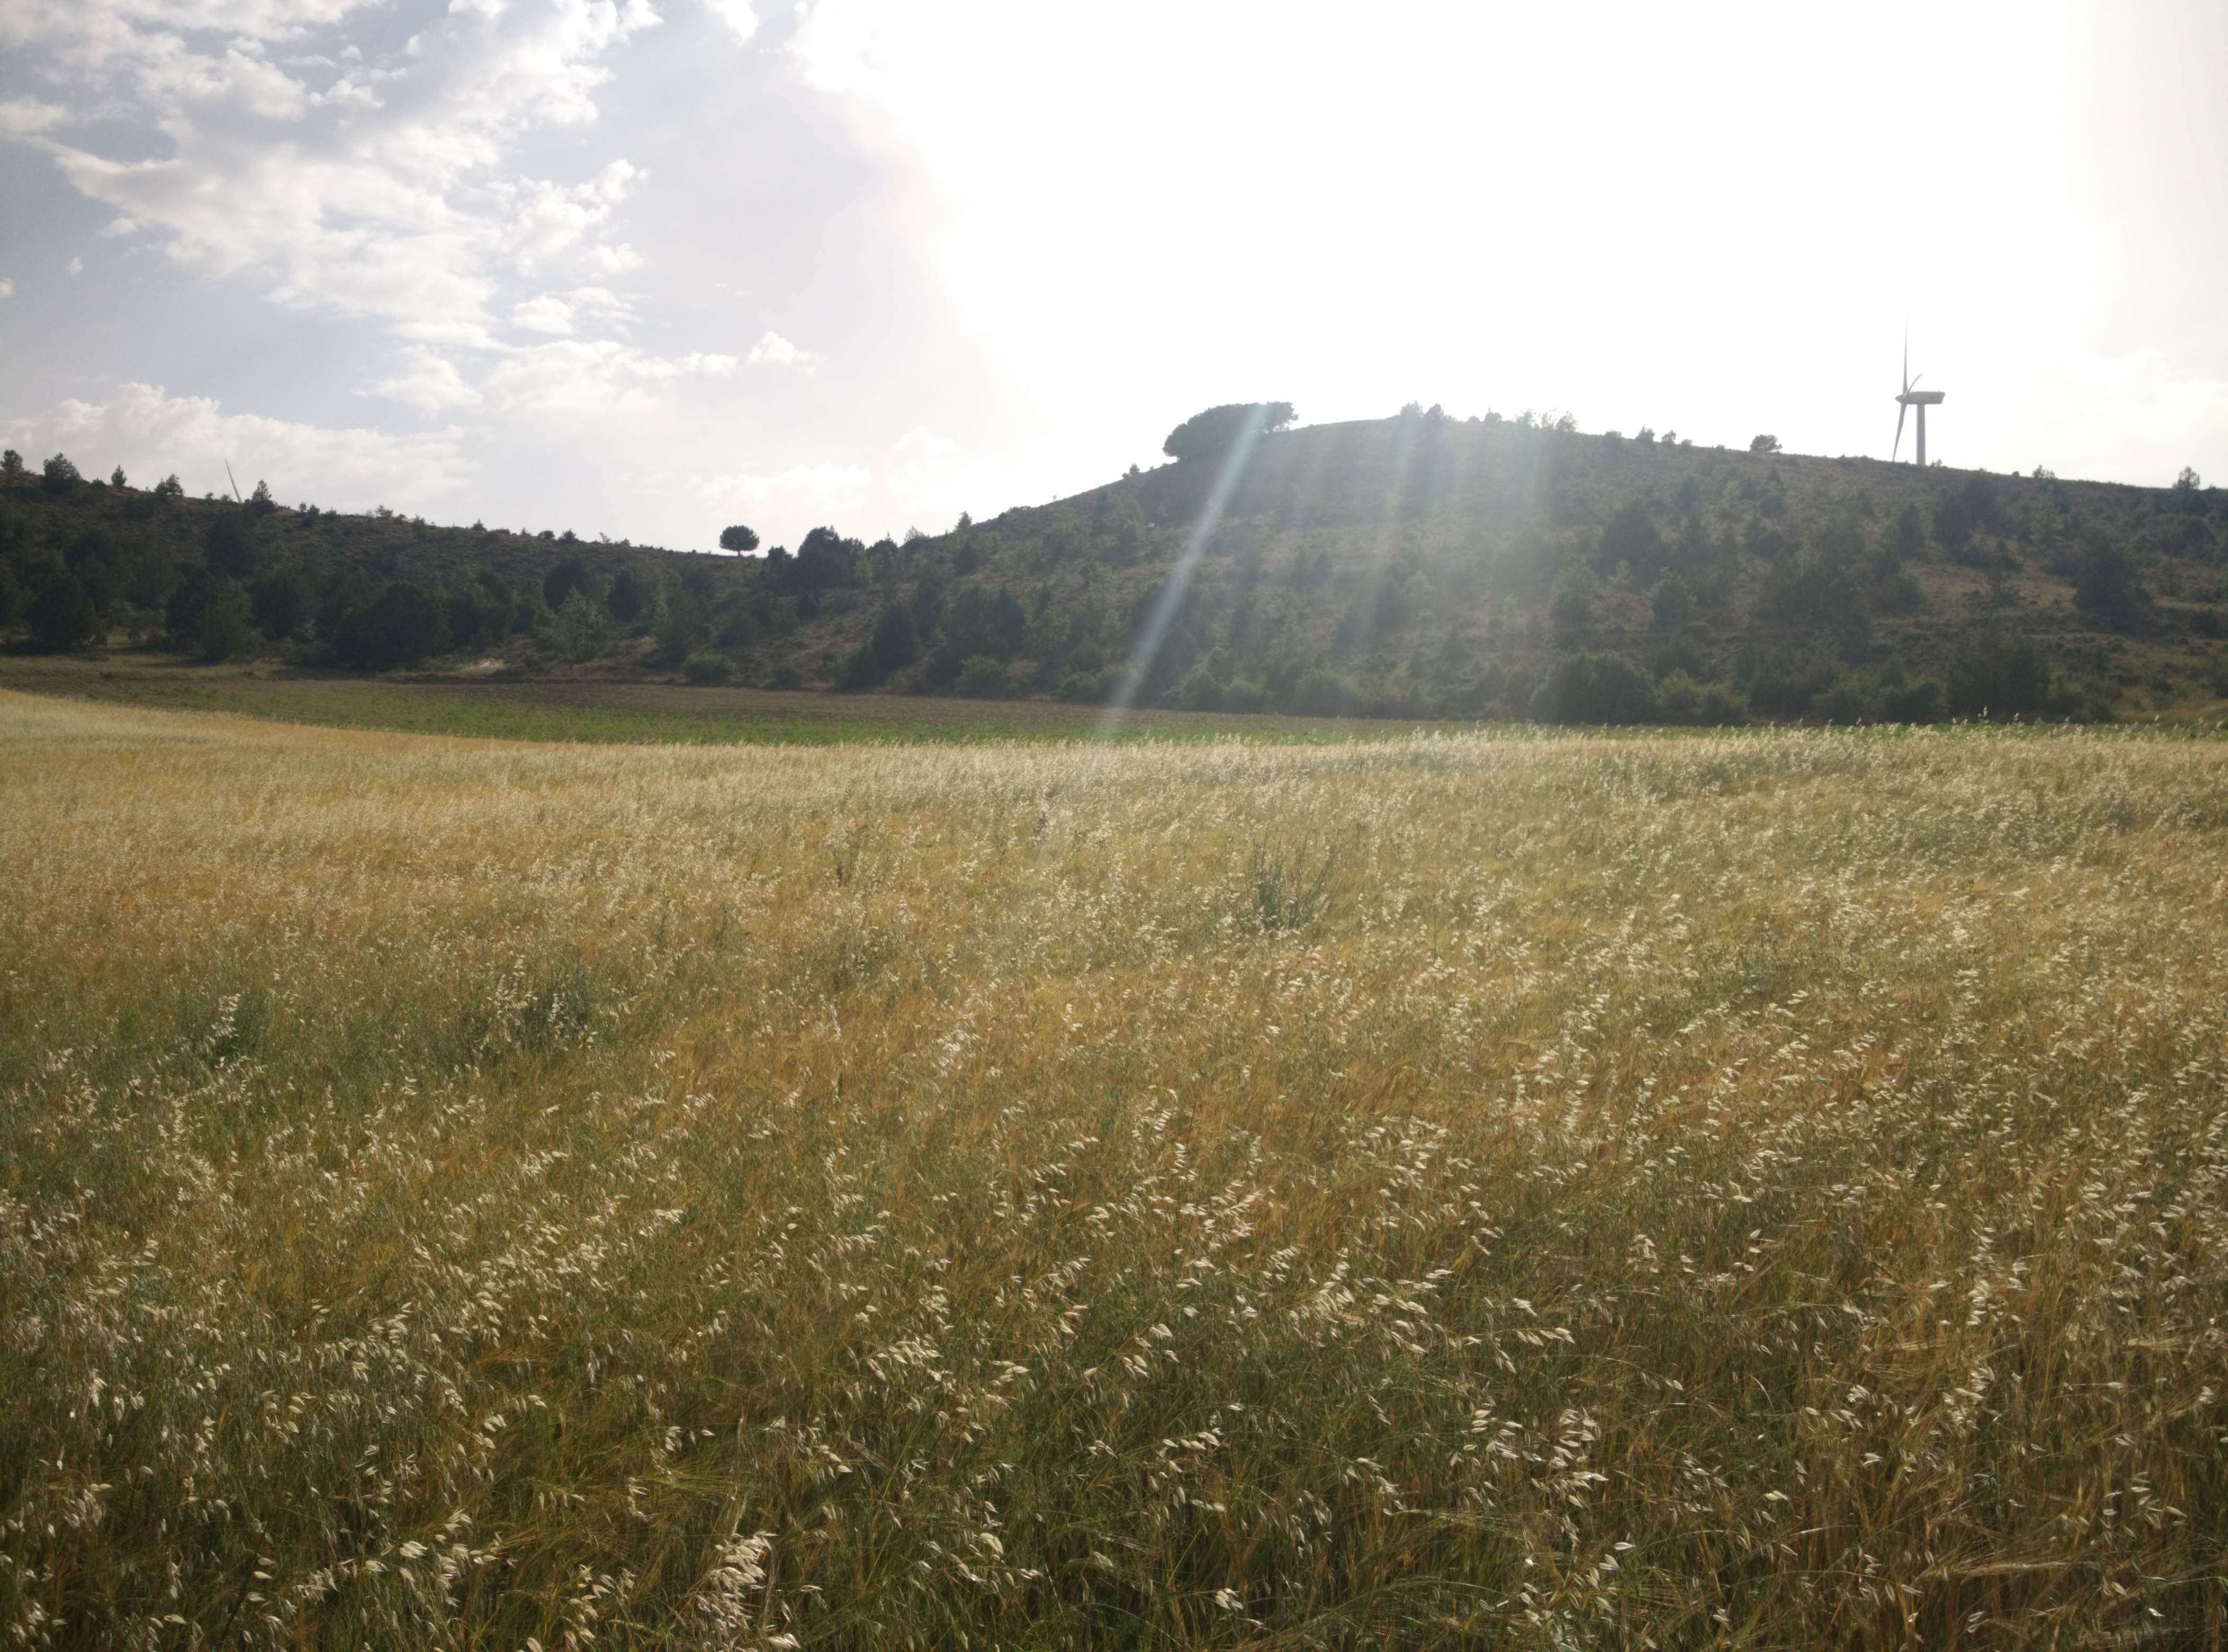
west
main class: Cropland
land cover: Barley
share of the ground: > 75 %
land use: Agriculture (excluding fallow land and kitchen gardens)
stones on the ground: 25 - 50 %
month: July
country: ES
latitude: 41.0288
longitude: -2.1223
